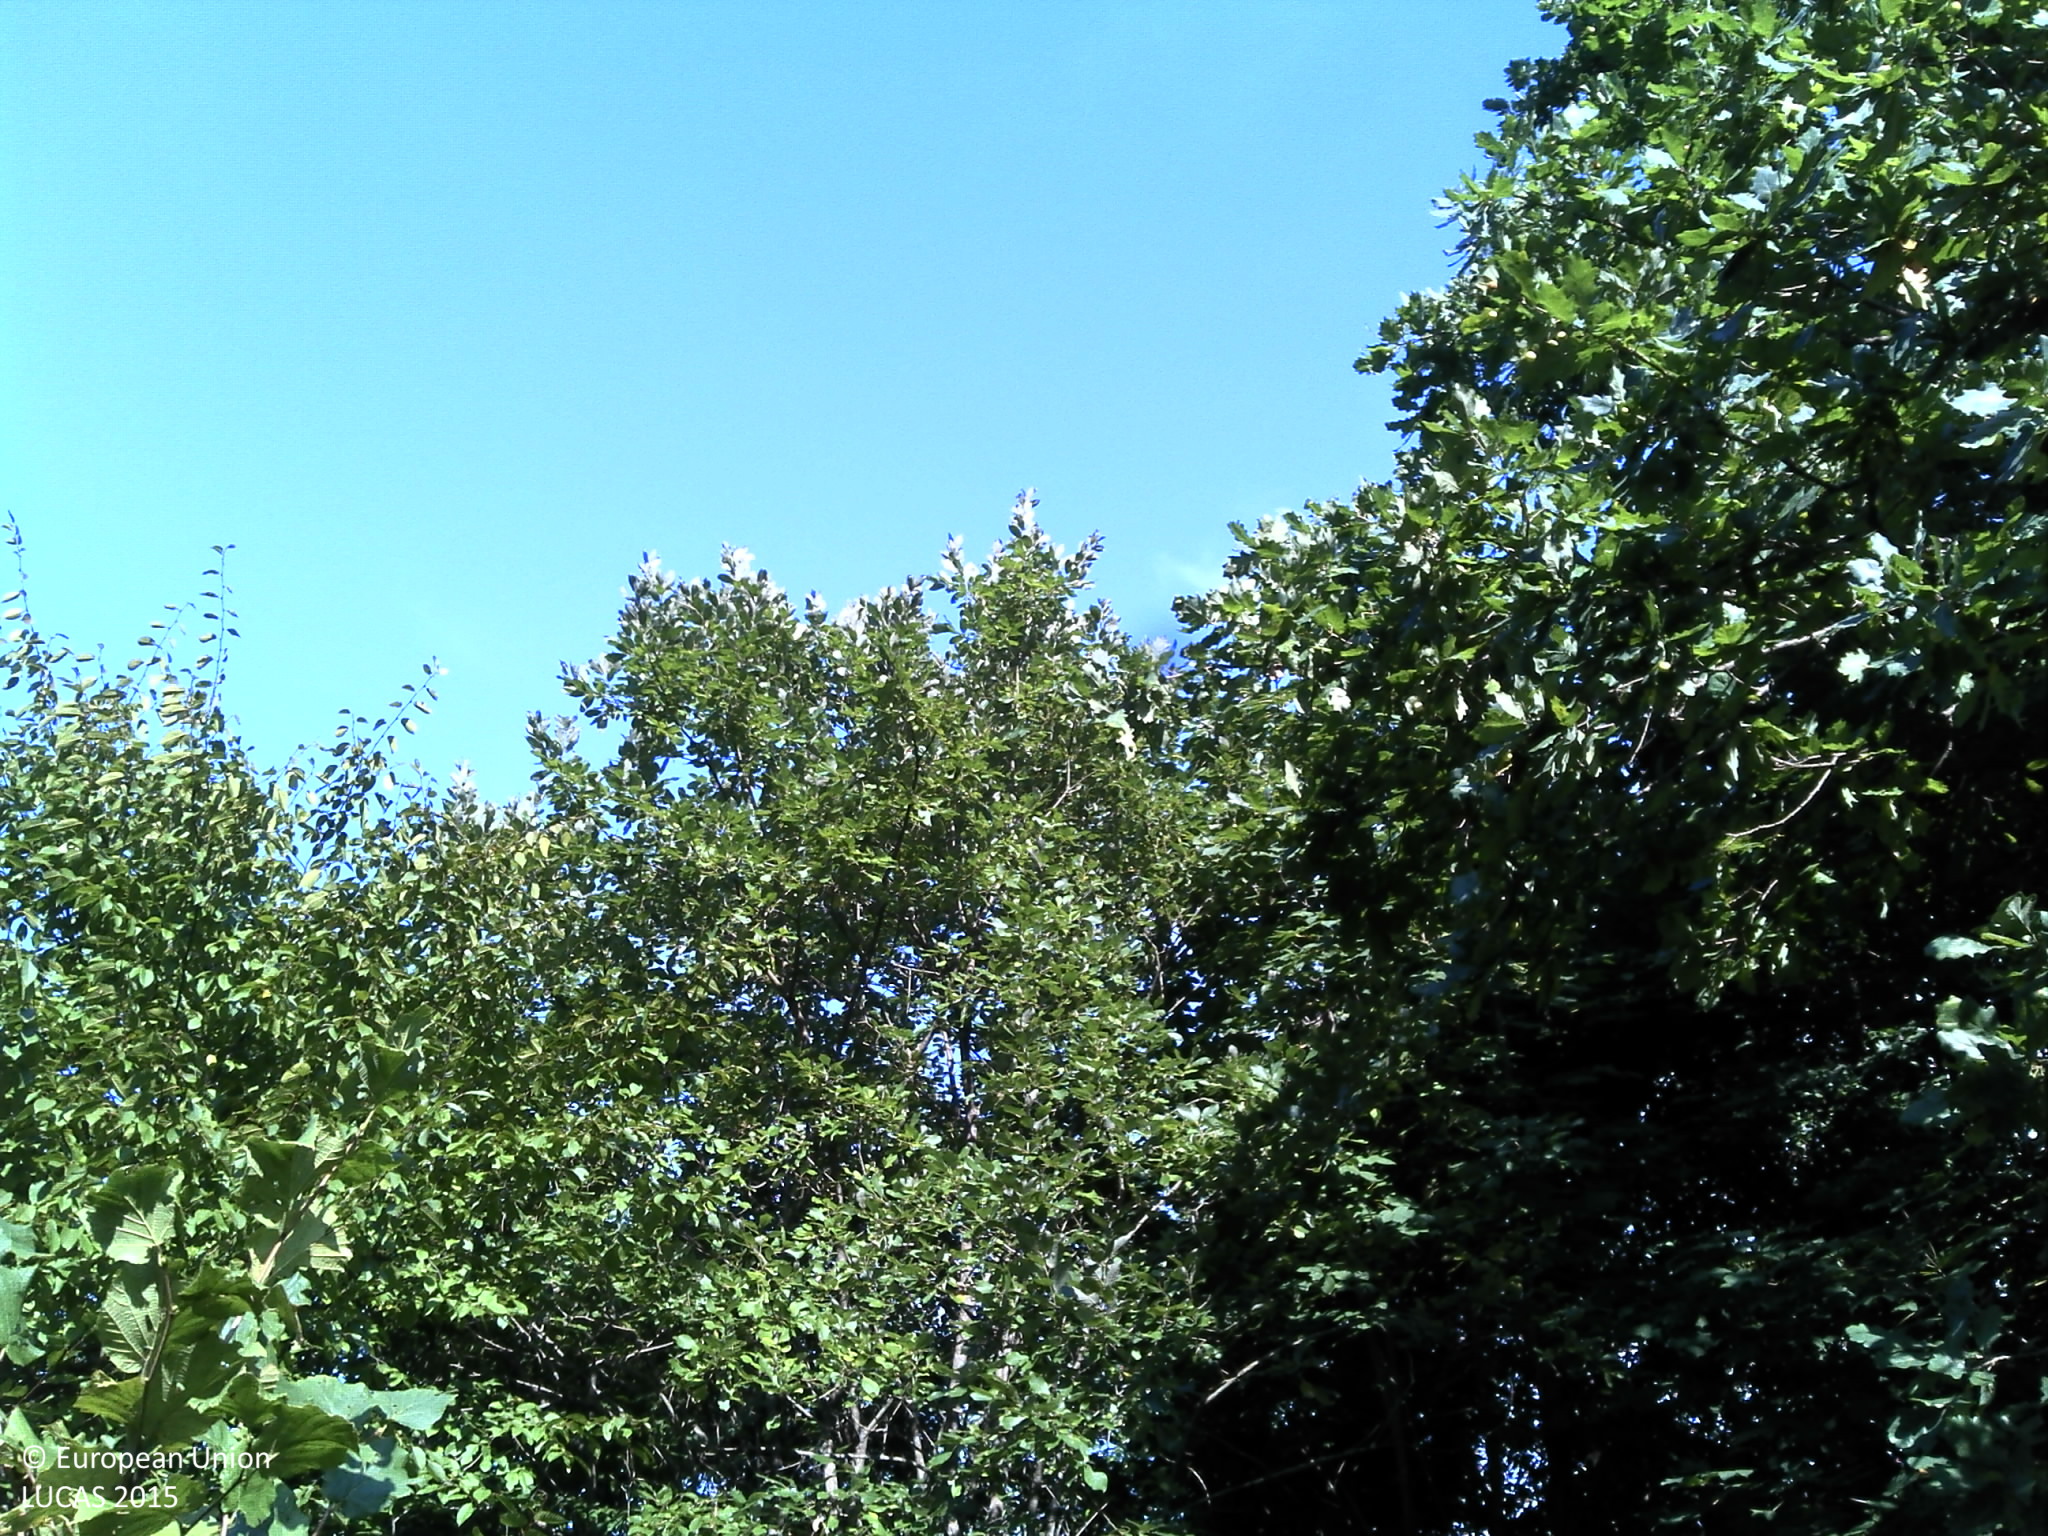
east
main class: Shrubland
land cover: Shrubland without tree cover
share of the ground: > 75 %
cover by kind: shrubs 100 %
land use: Semi-natural and natural areas not in use
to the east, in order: Shrubland without tree cover; Broadleaved woodland; Shrubland without tree cover; Broadleaved woodland; Shrubland without tree cover
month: September
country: HR
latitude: 45.0629
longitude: 15.6720
